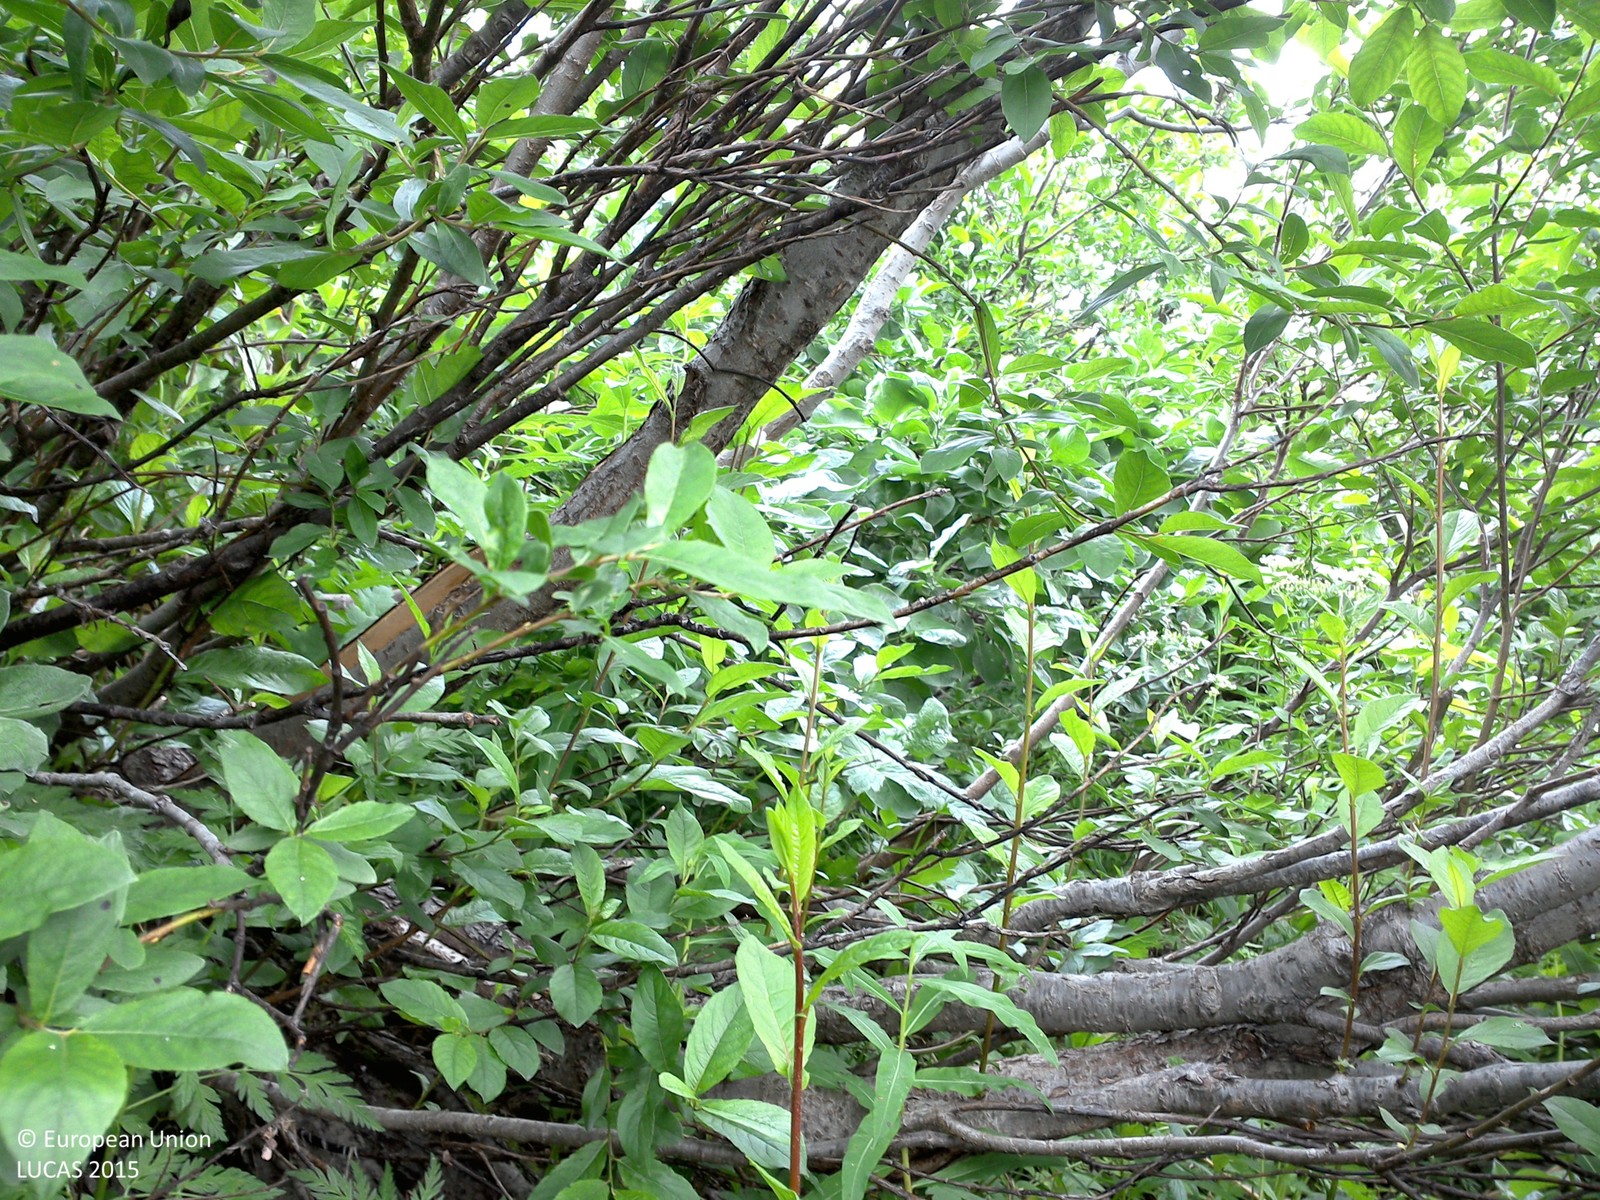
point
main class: Woodland
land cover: Broadleaved woodland
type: non-riverine alder, birch or aspen forest
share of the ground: > 75 %
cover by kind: broadleaved forest trees 90 %, shrubs 10 %
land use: Semi-natural and natural areas not in use
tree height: < 5 m
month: August
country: SE
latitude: 68.3866
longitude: 18.7139
